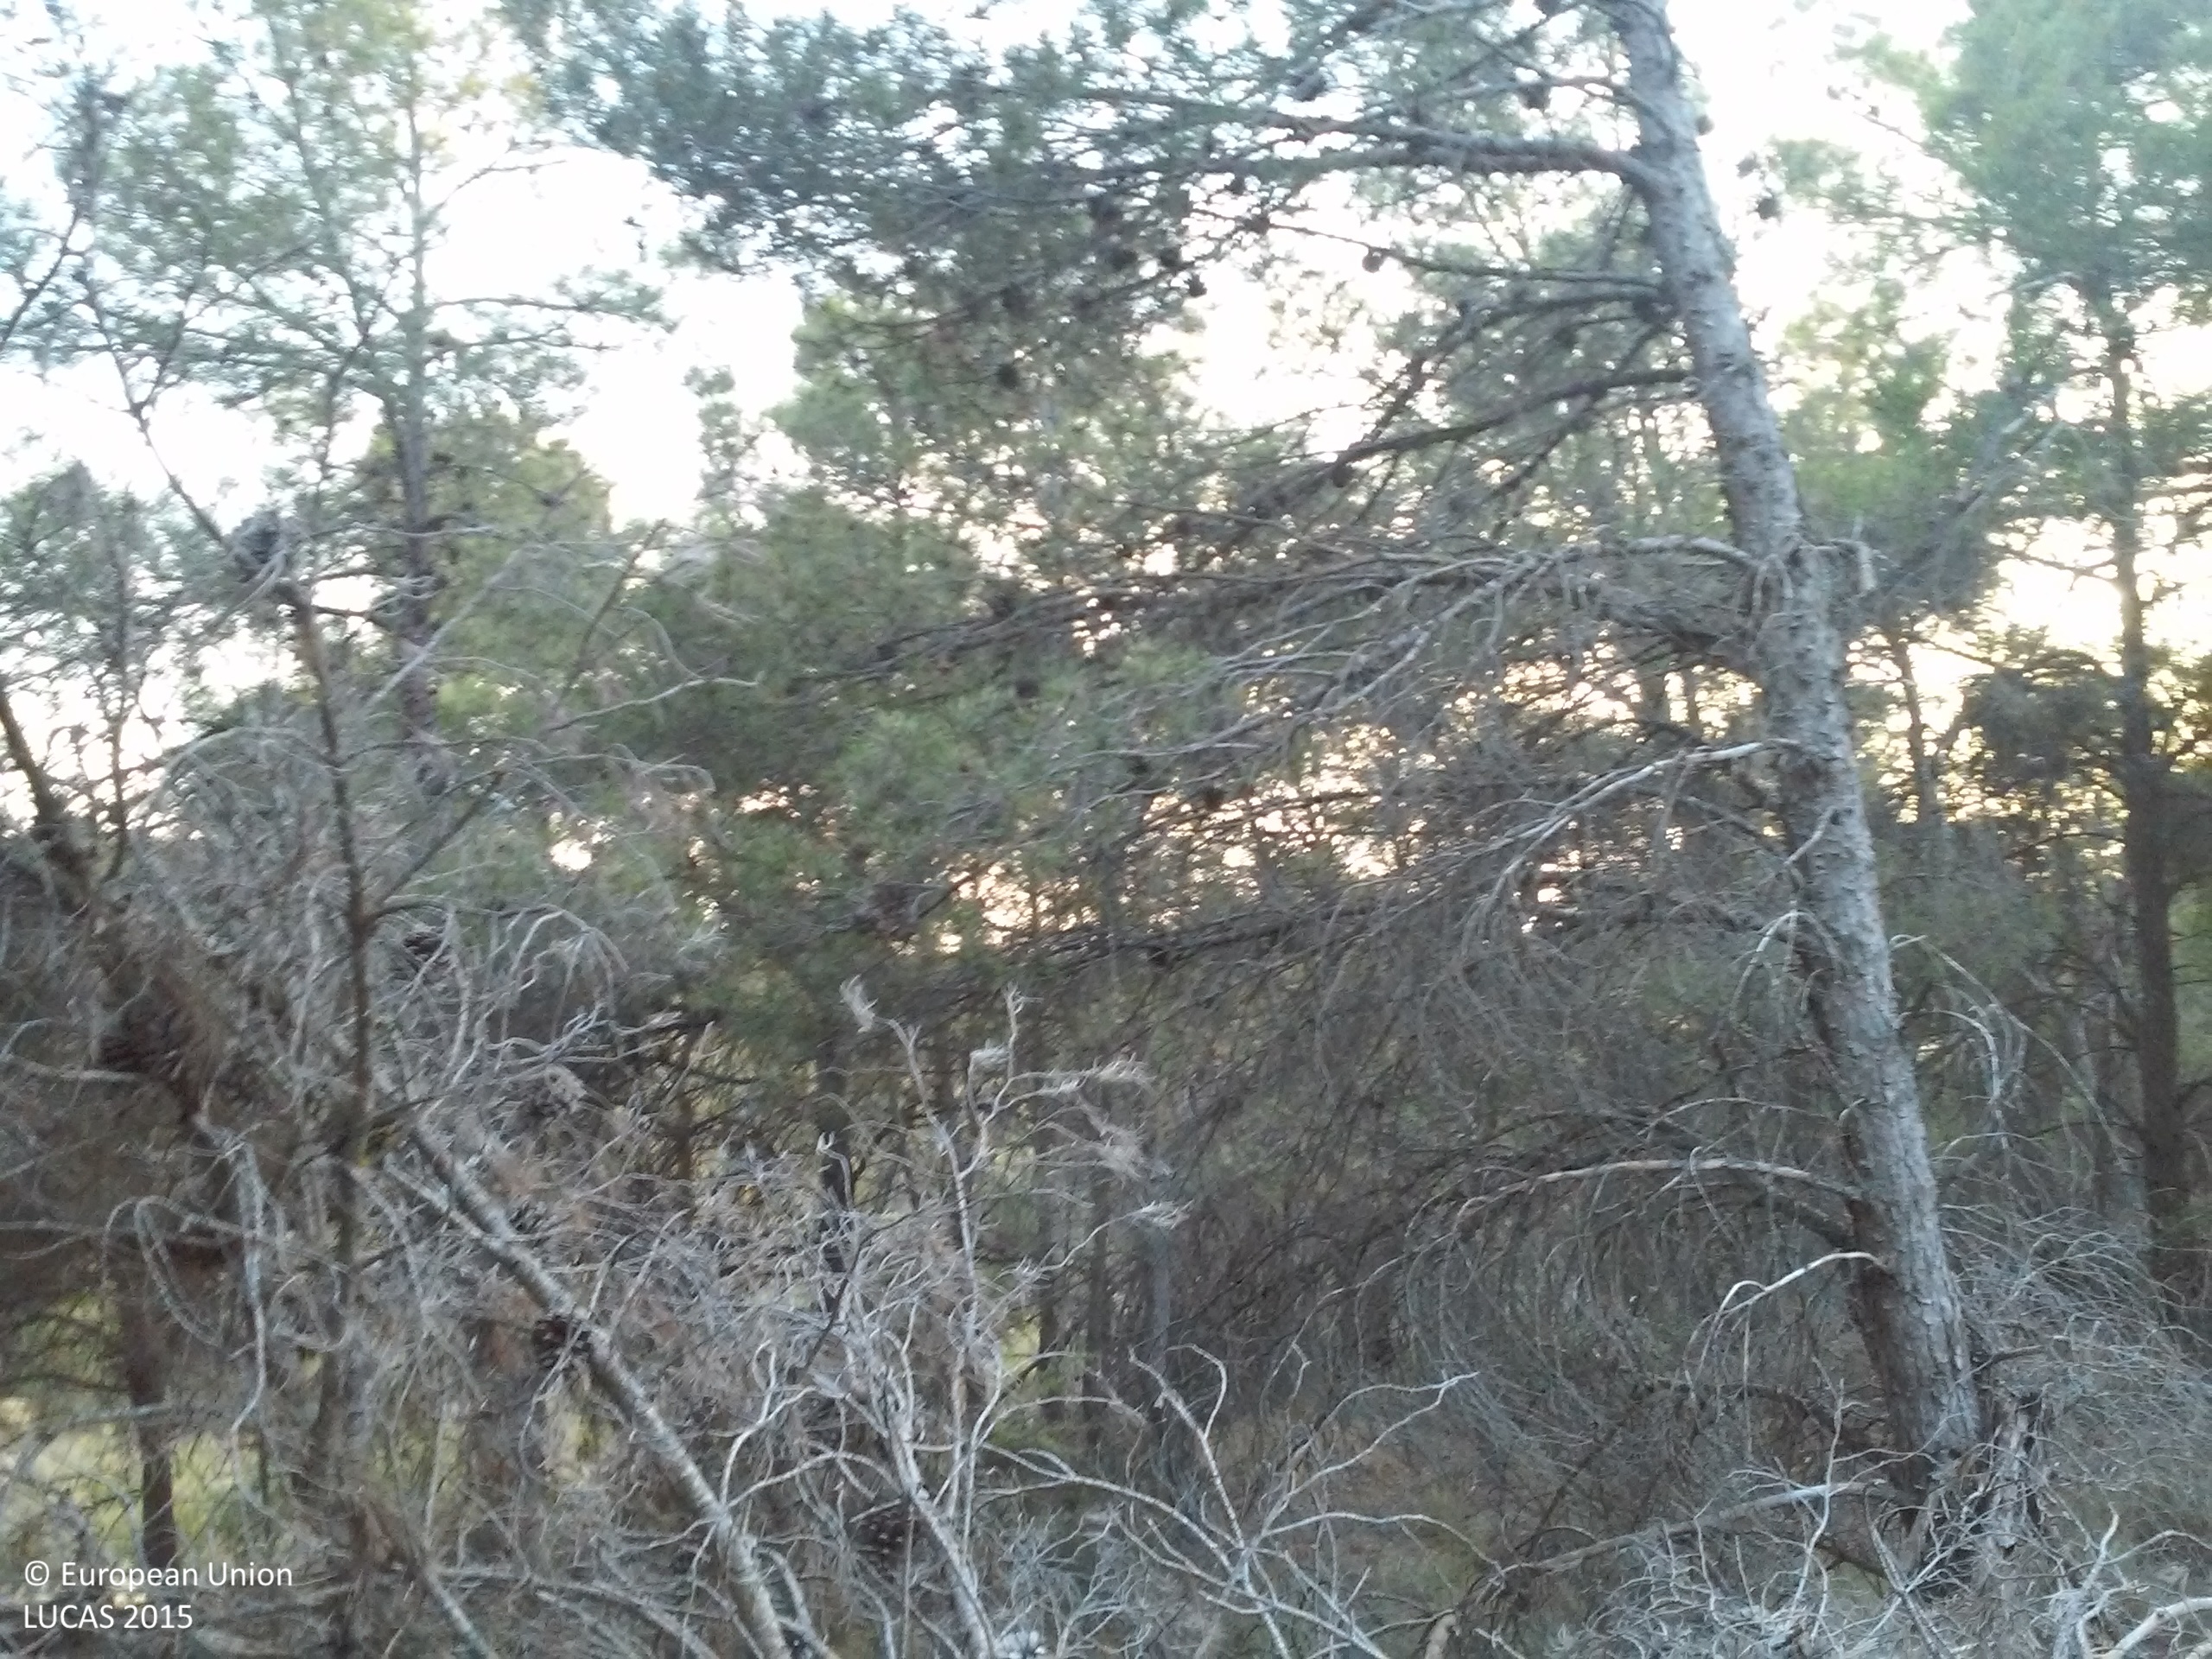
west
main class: Woodland
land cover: Pine dominated coniferous woodland
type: coniferous forest of the mediterranean region
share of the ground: 25 - 50 %
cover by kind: coniferous forest trees 60 %, shrubs 15 %, herbaceous plants 15 %, lichens and mosses 10 %
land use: Semi-natural and natural areas not in use
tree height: > 5 m
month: July
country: ES
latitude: 41.5980
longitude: 1.1959
